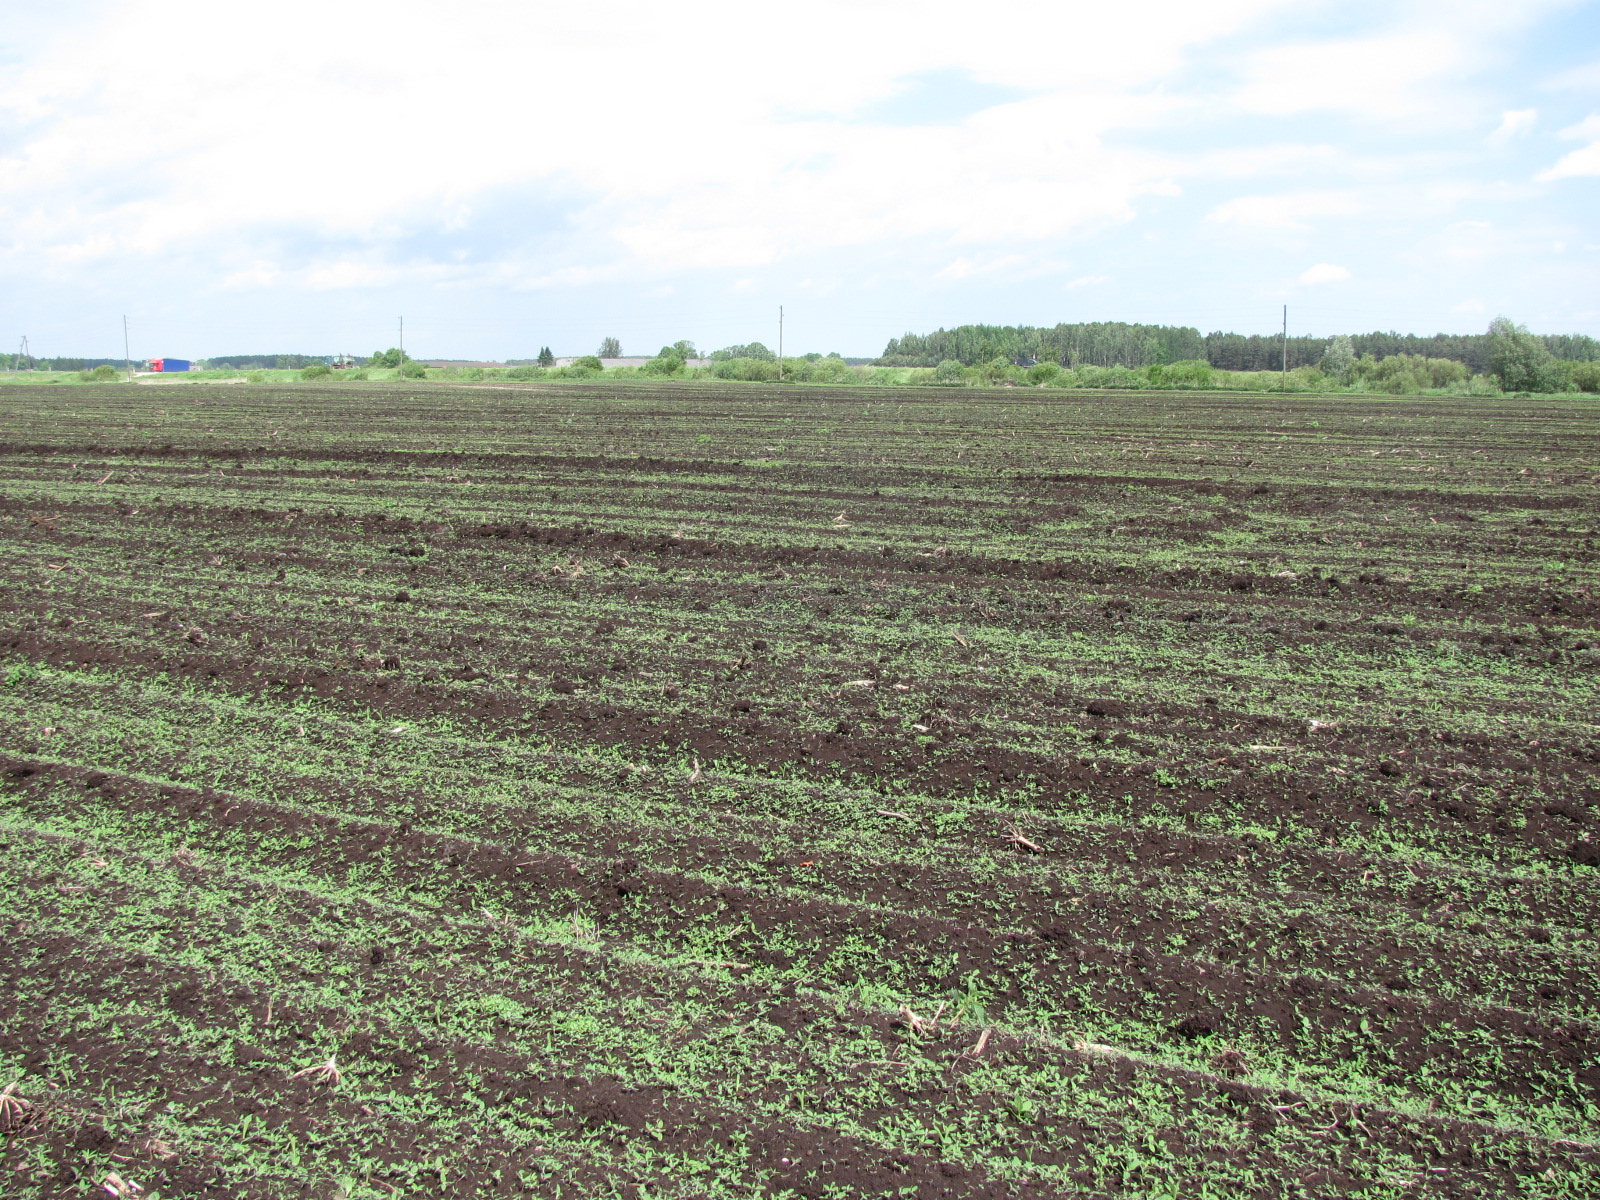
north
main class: Cropland
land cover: Maize
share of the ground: < 10 %
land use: Agriculture (excluding fallow land and kitchen gardens)
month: June
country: LV
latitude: 56.8622
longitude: 23.9755
